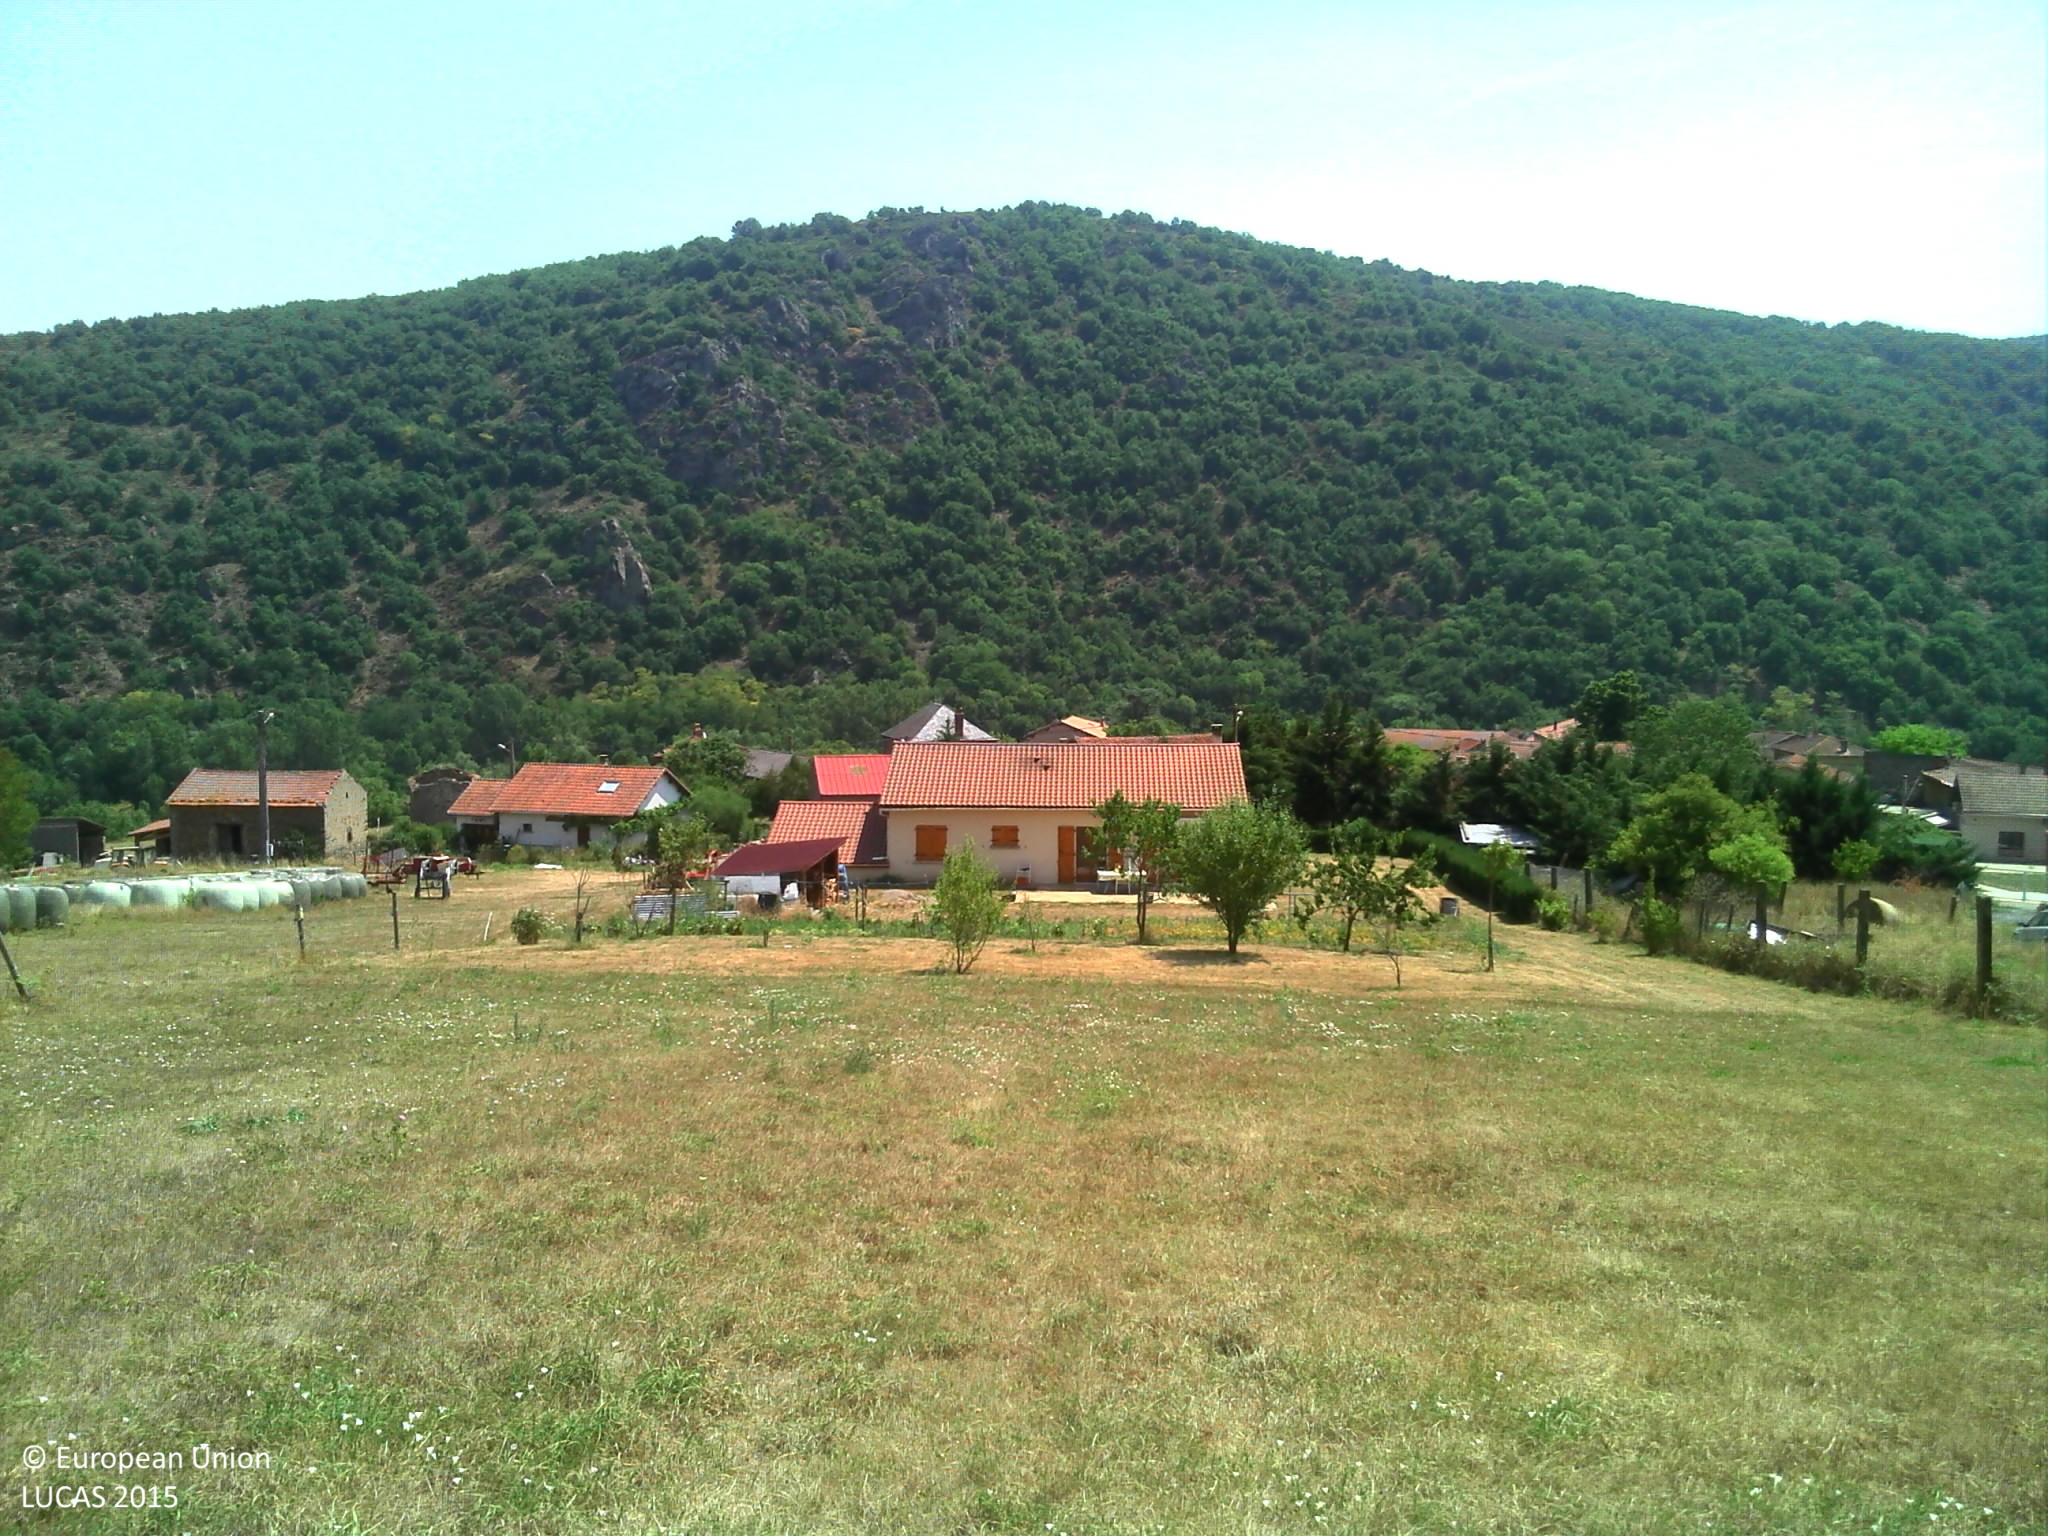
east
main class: Grassland
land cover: Grassland without tree/shrub cover
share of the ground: > 75 %
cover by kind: herbaceous plants 100 %
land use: Agriculture (excluding fallow land and kitchen gardens)
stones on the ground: < 10 %
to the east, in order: Grassland without tree/shrub cover; Artificial constructions in urban areas; Broadleaved woodland; Railways
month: July
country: FR
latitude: 45.3393
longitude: 3.1997
